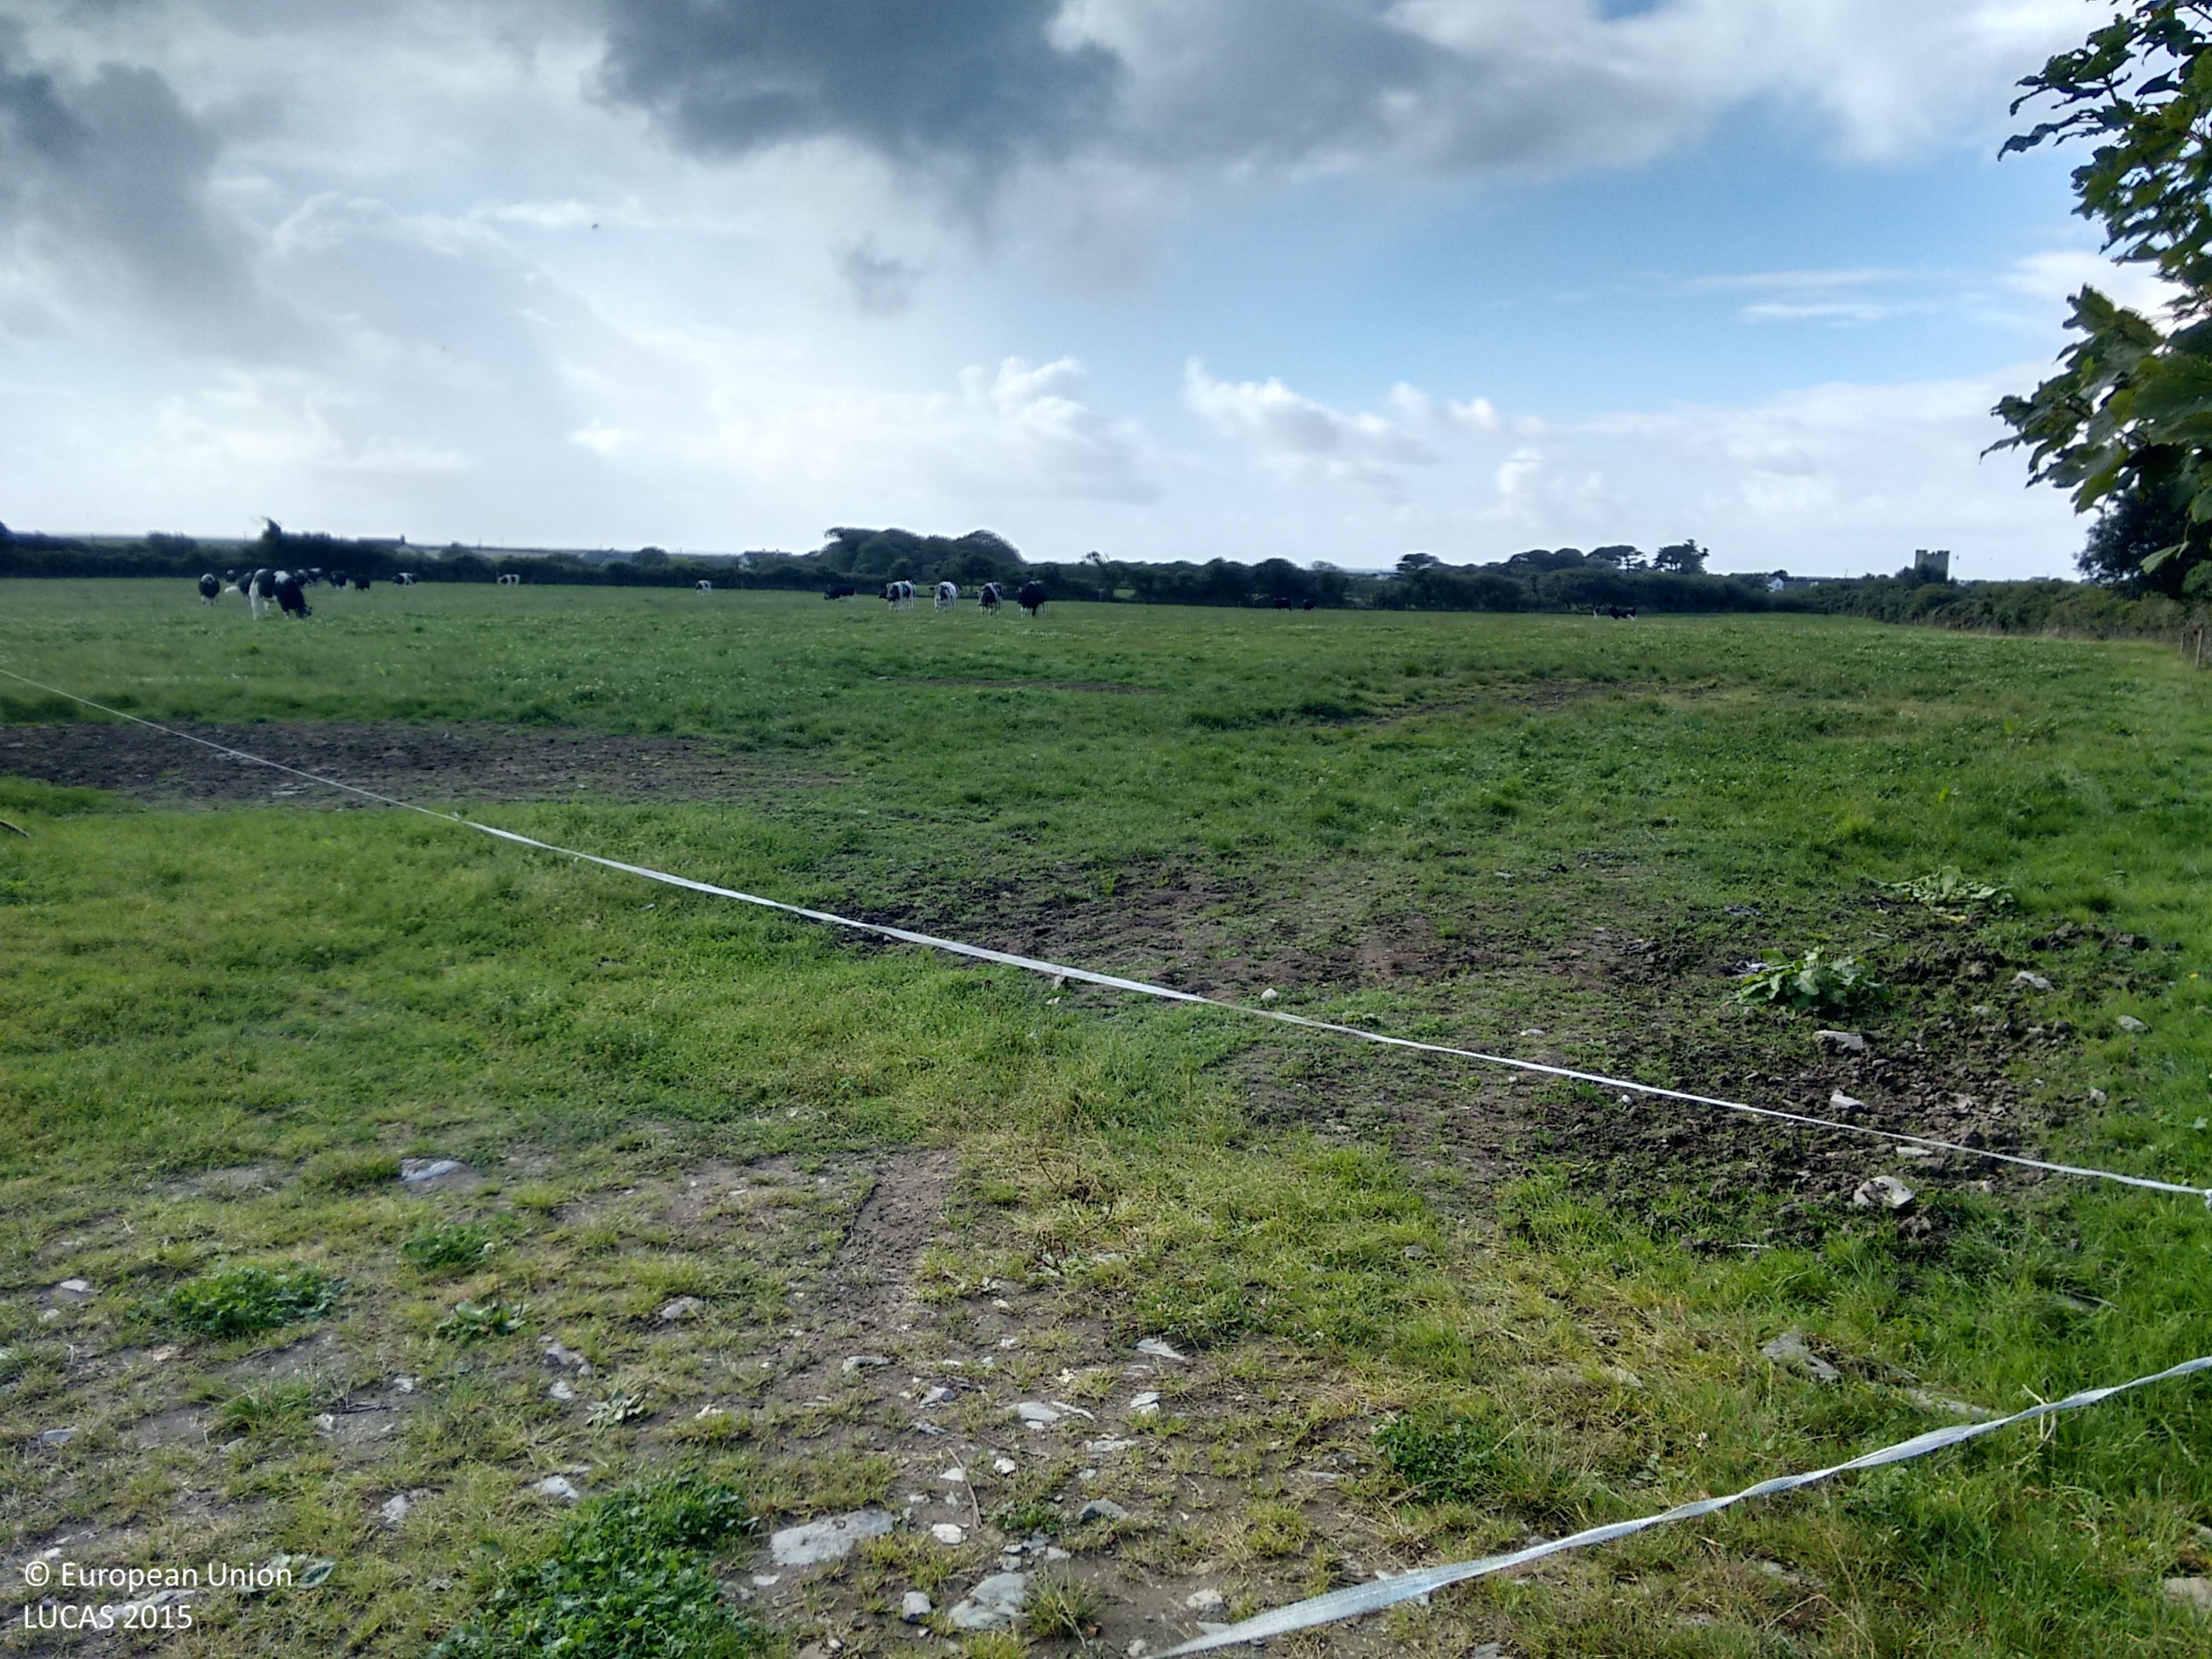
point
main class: Grassland
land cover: Grassland without tree/shrub cover
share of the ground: > 75 %
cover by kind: herbaceous plants 100 %
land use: Agriculture (excluding fallow land and kitchen gardens)
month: August
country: IE
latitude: 52.1991
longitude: -6.5301
